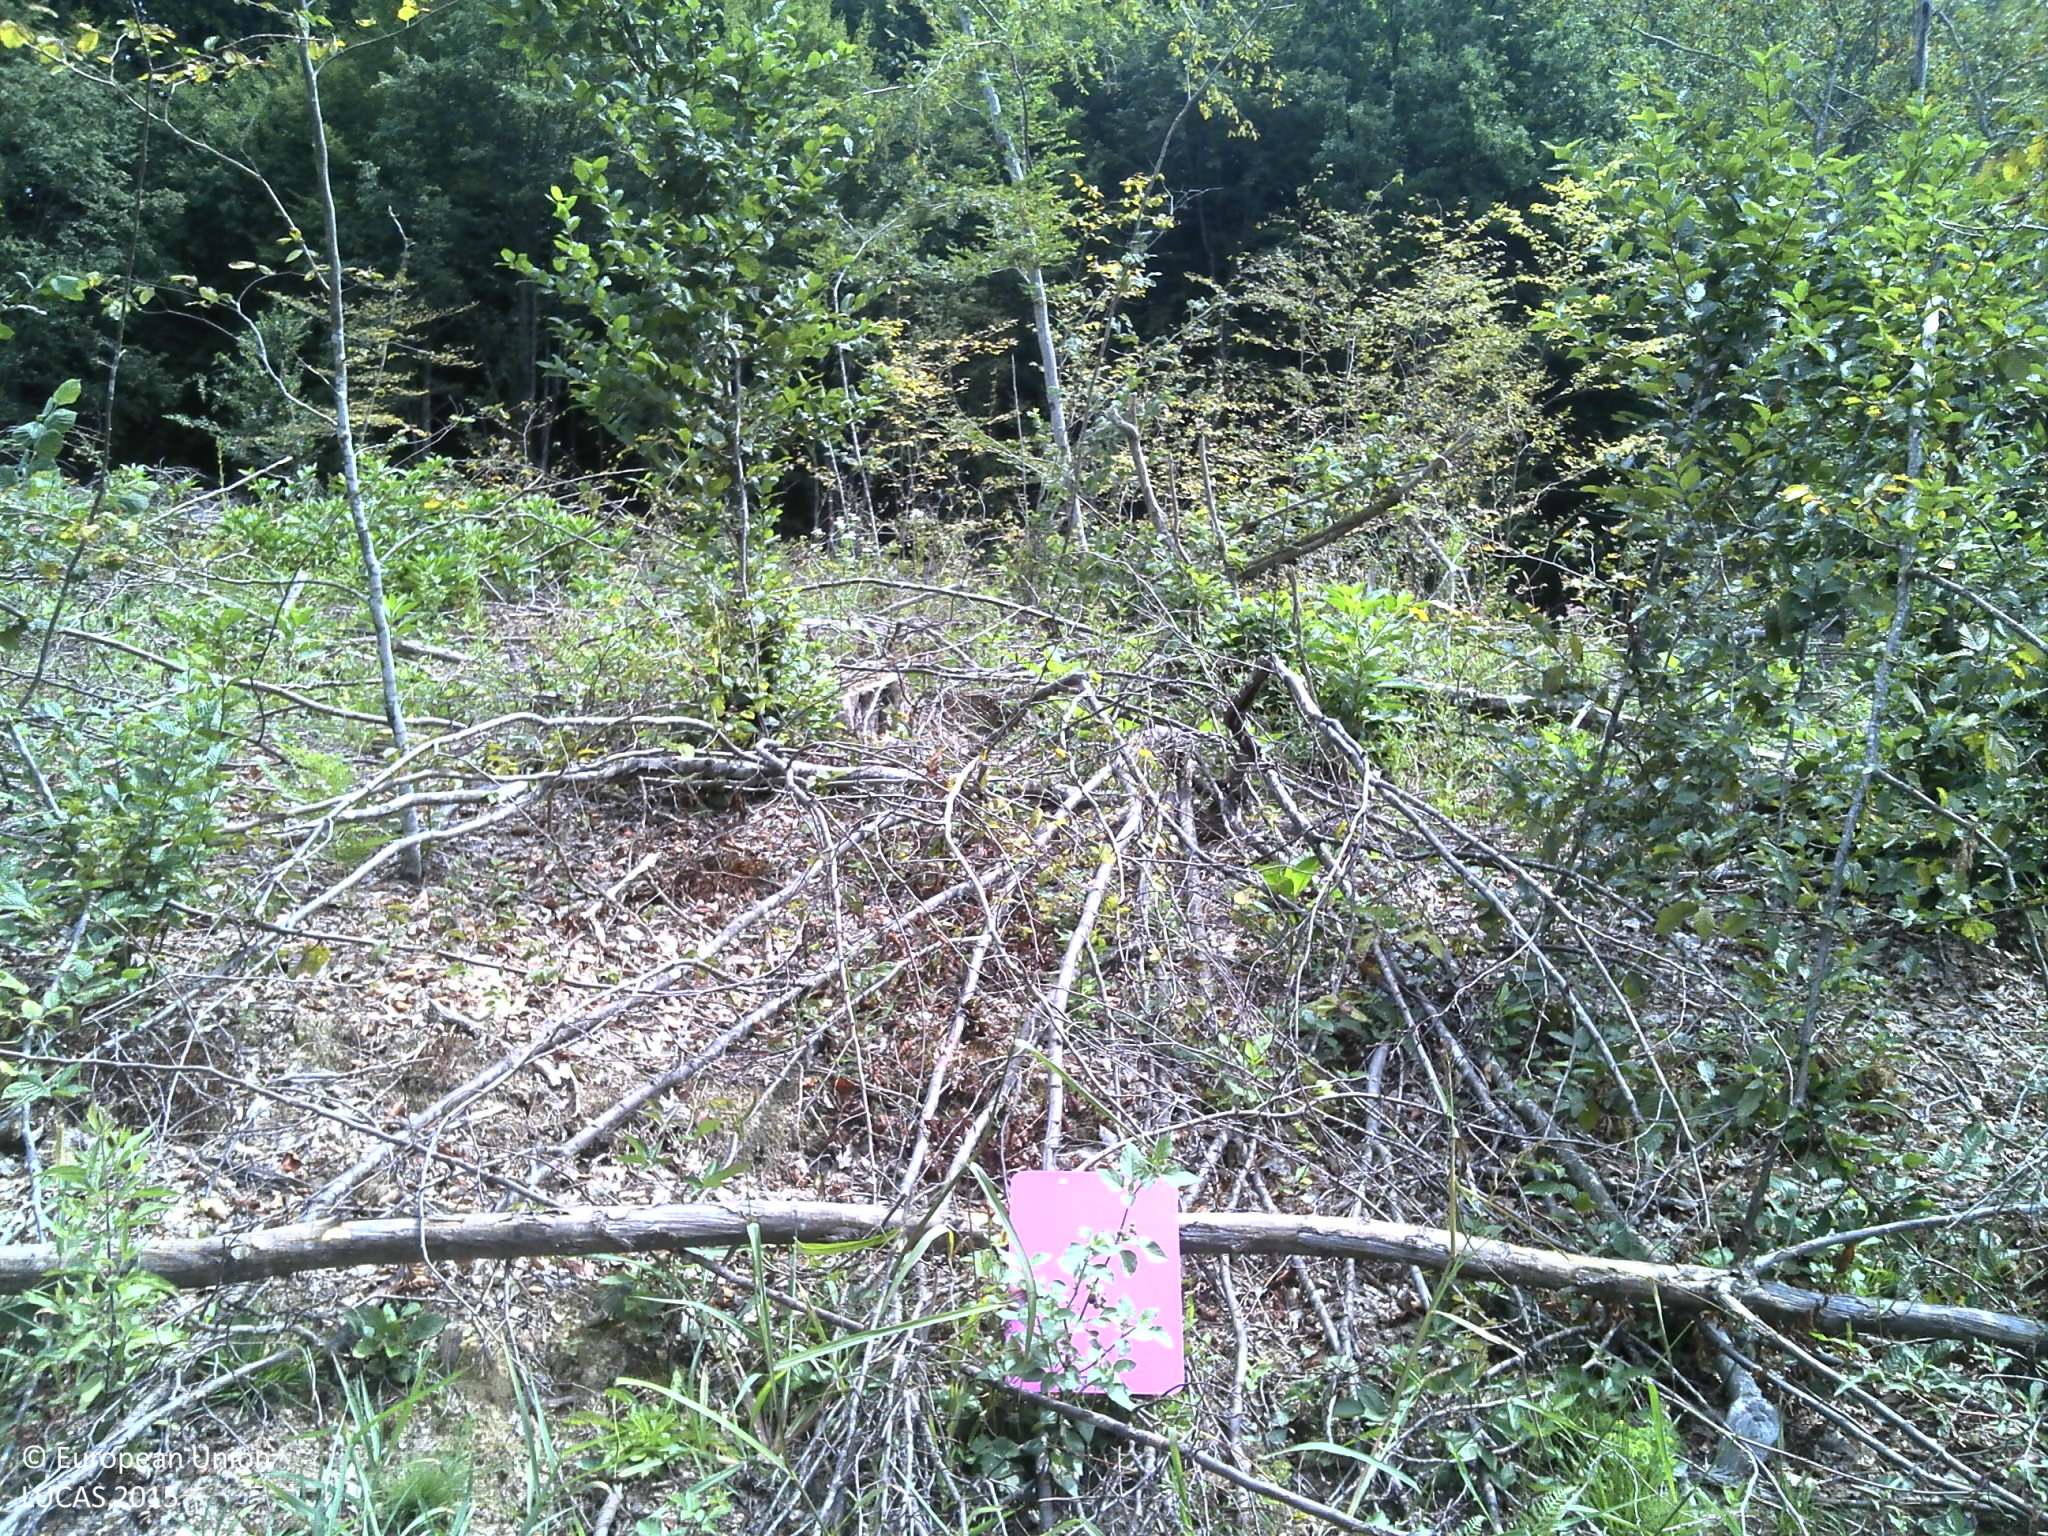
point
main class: Woodland
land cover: Broadleaved woodland
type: beech forest
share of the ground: > 75 %
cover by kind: broadleaved forest trees 100 %
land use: Forestry
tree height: > 5 m
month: August
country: HR
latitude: 45.3363
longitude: 15.9557
